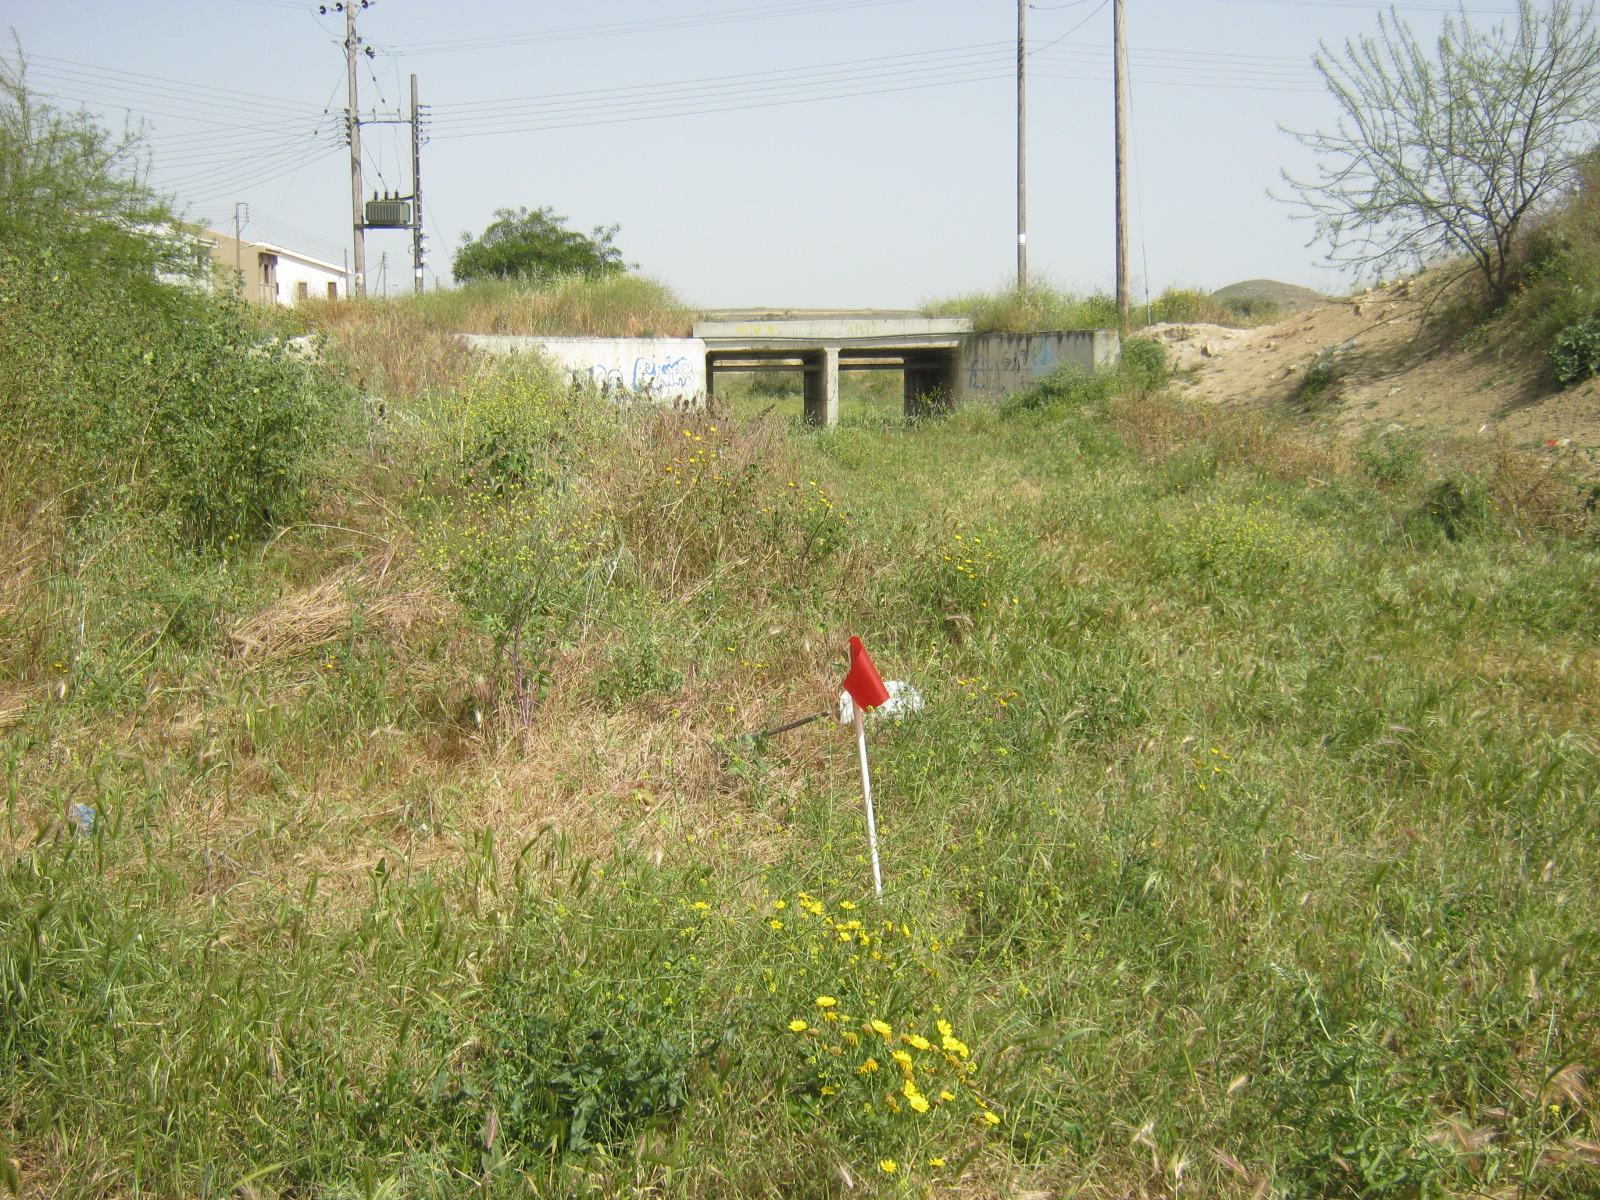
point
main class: Grassland
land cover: Spontaneously vegetated surfaces
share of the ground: > 75 %
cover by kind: herbaceous plants 100 %
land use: Semi-natural and natural areas not in use
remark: Temporary dry
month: April
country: CY
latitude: 35.0991
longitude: 33.4174
